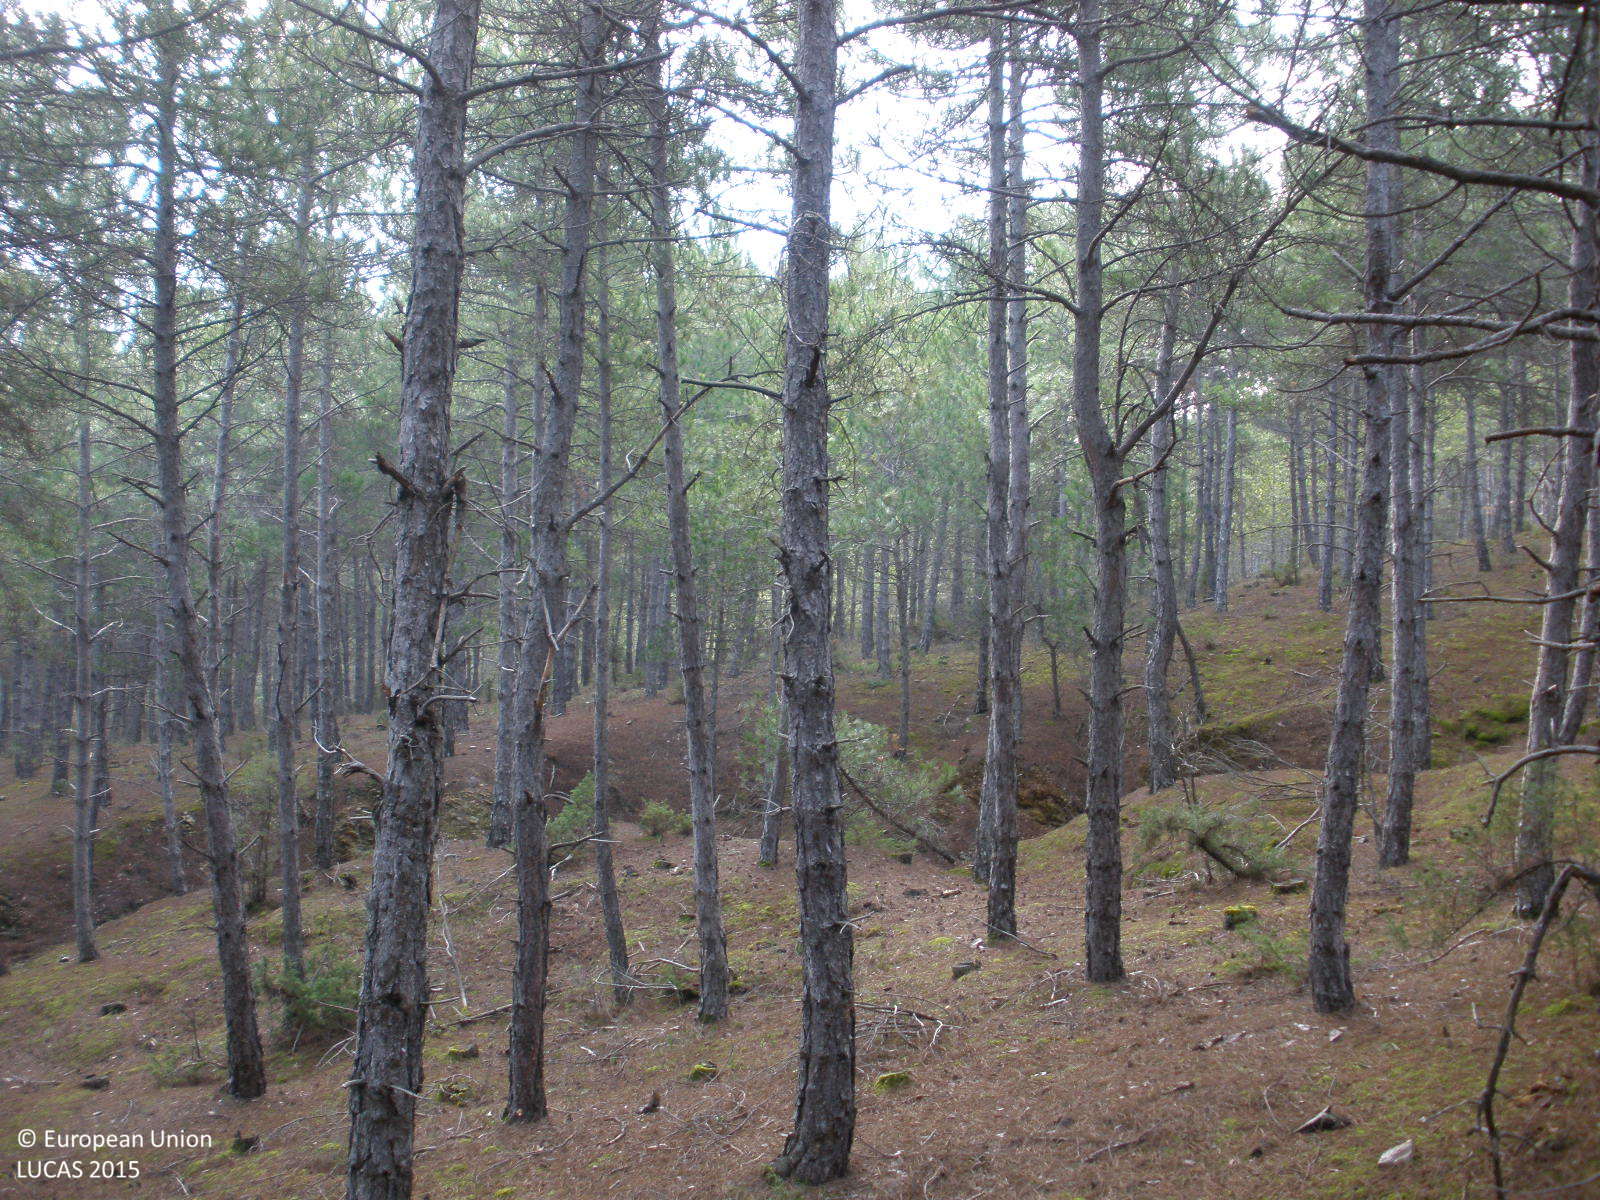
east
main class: Woodland
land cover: Pine dominated coniferous woodland
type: coniferous forest of the mediterranean region
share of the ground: > 75 %
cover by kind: coniferous forest trees 90 %, consolidated bare surface 10 %
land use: Forestry
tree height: < 5 m
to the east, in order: Pine dominated coniferous woodland; Rivers and streams; Pine dominated coniferous woodland; Tracks; Pine dominated coniferous woodland; Tracks
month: April
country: ES
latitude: 41.1425
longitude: -1.1589
